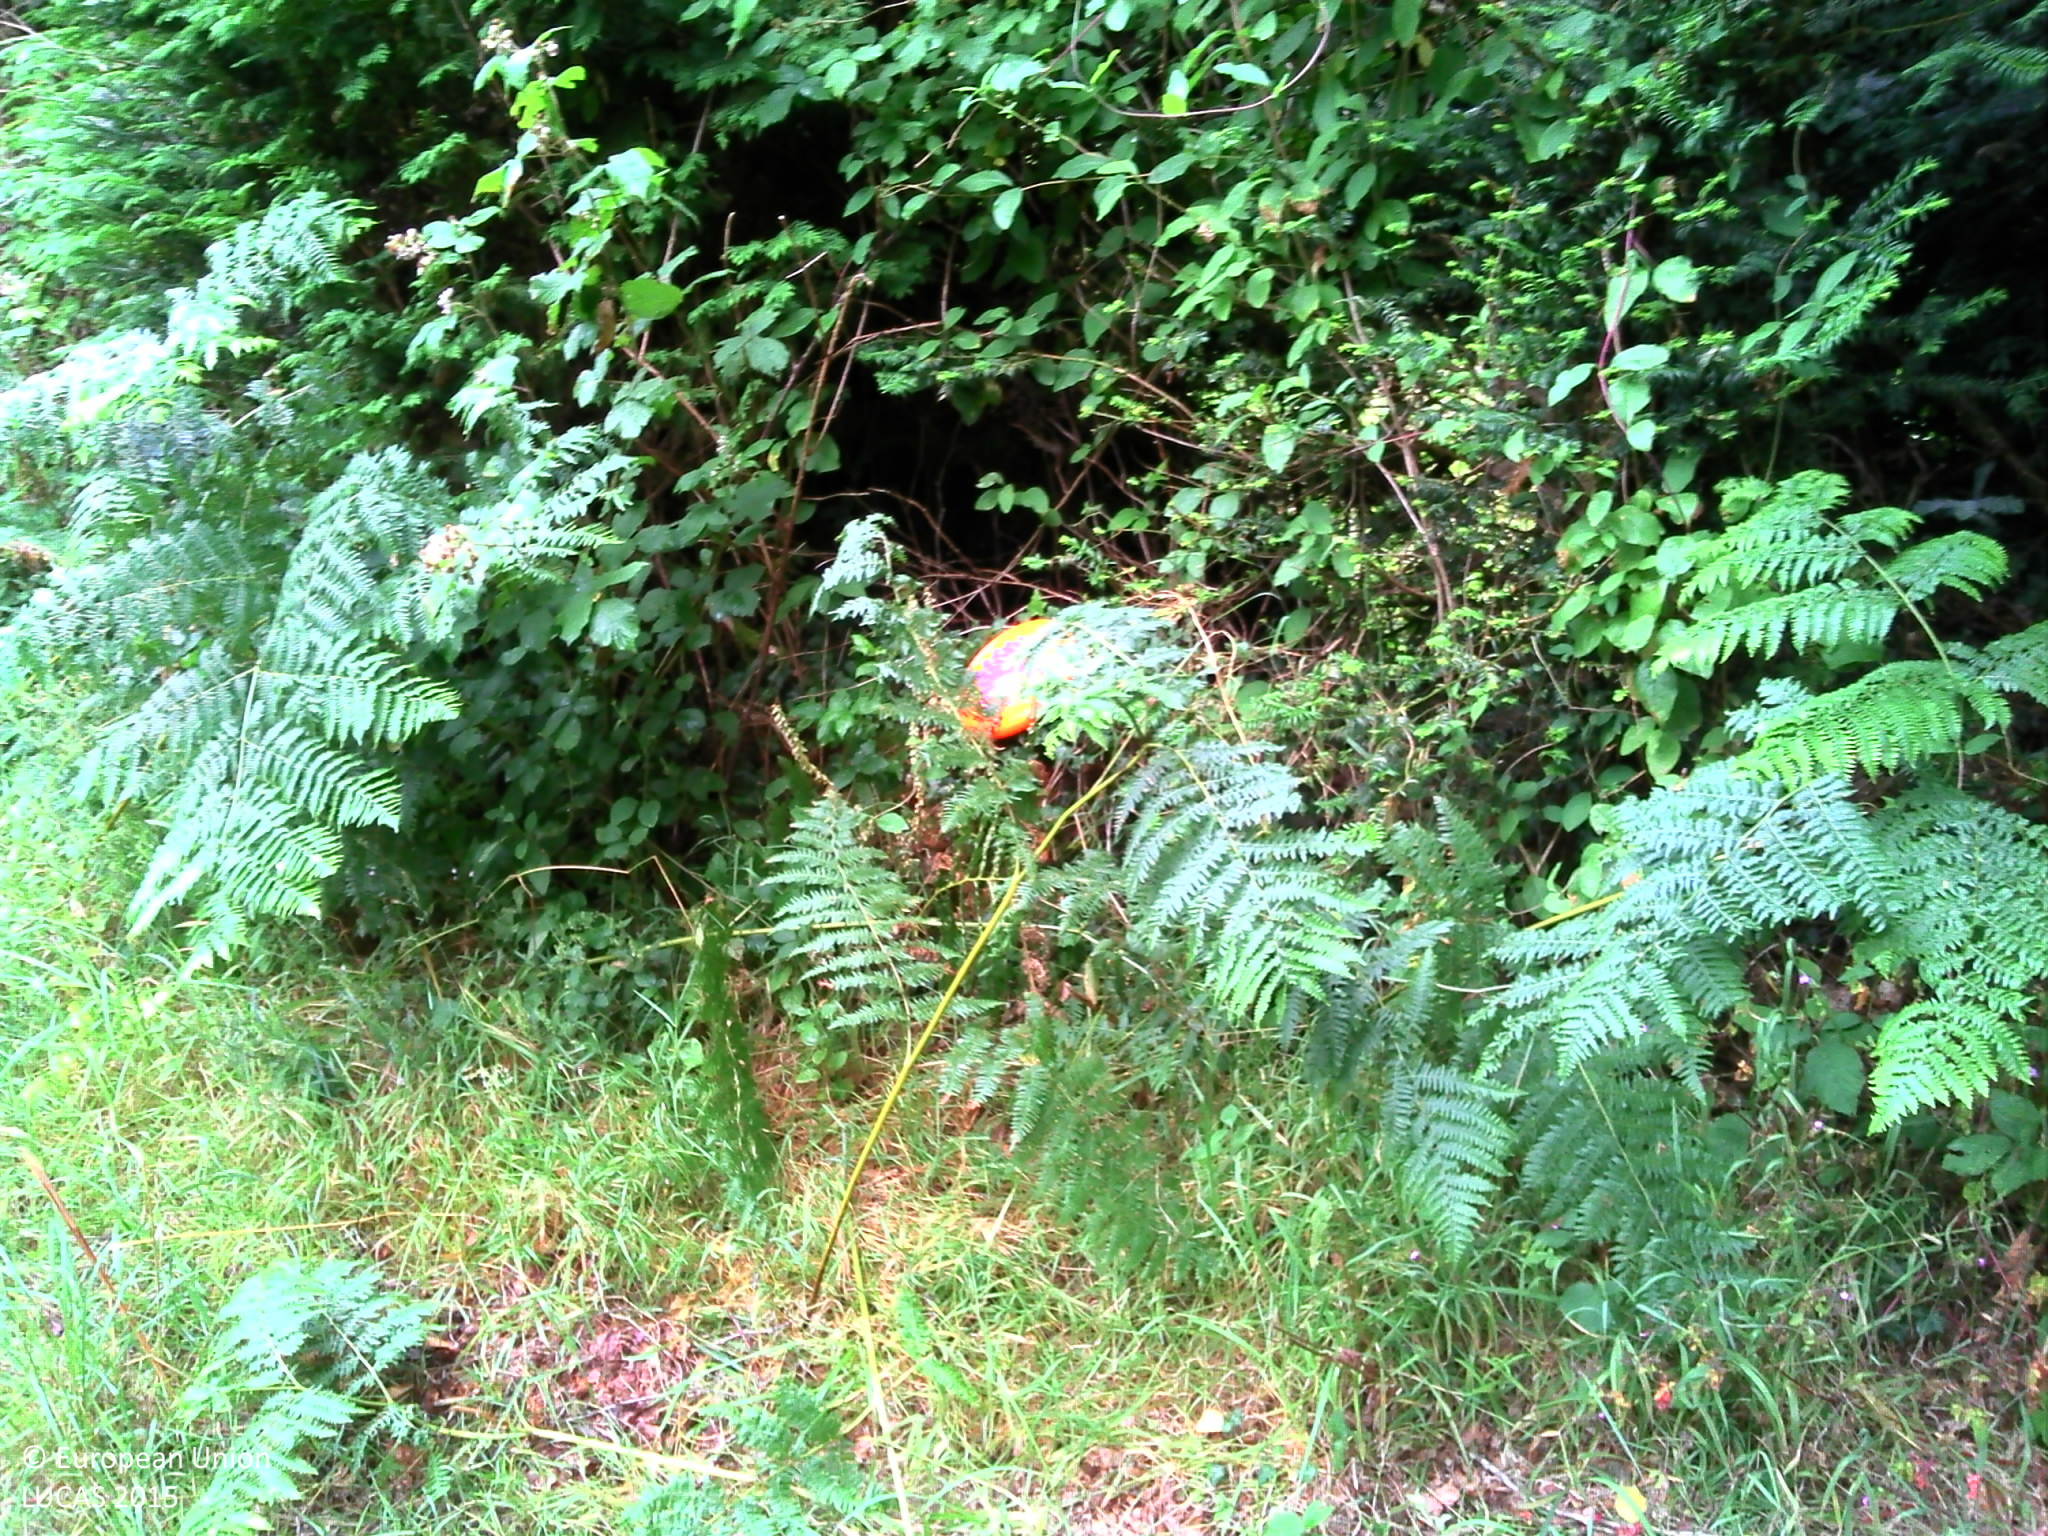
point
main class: Shrubland
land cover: Shrubland without tree cover
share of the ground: > 75 %
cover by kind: shrubs 65 %, herbaceous plants 25 %, consolidated bare surface 10 %
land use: Semi-natural and natural areas not in use
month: July
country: FR
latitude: 48.1119
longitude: -3.5500
